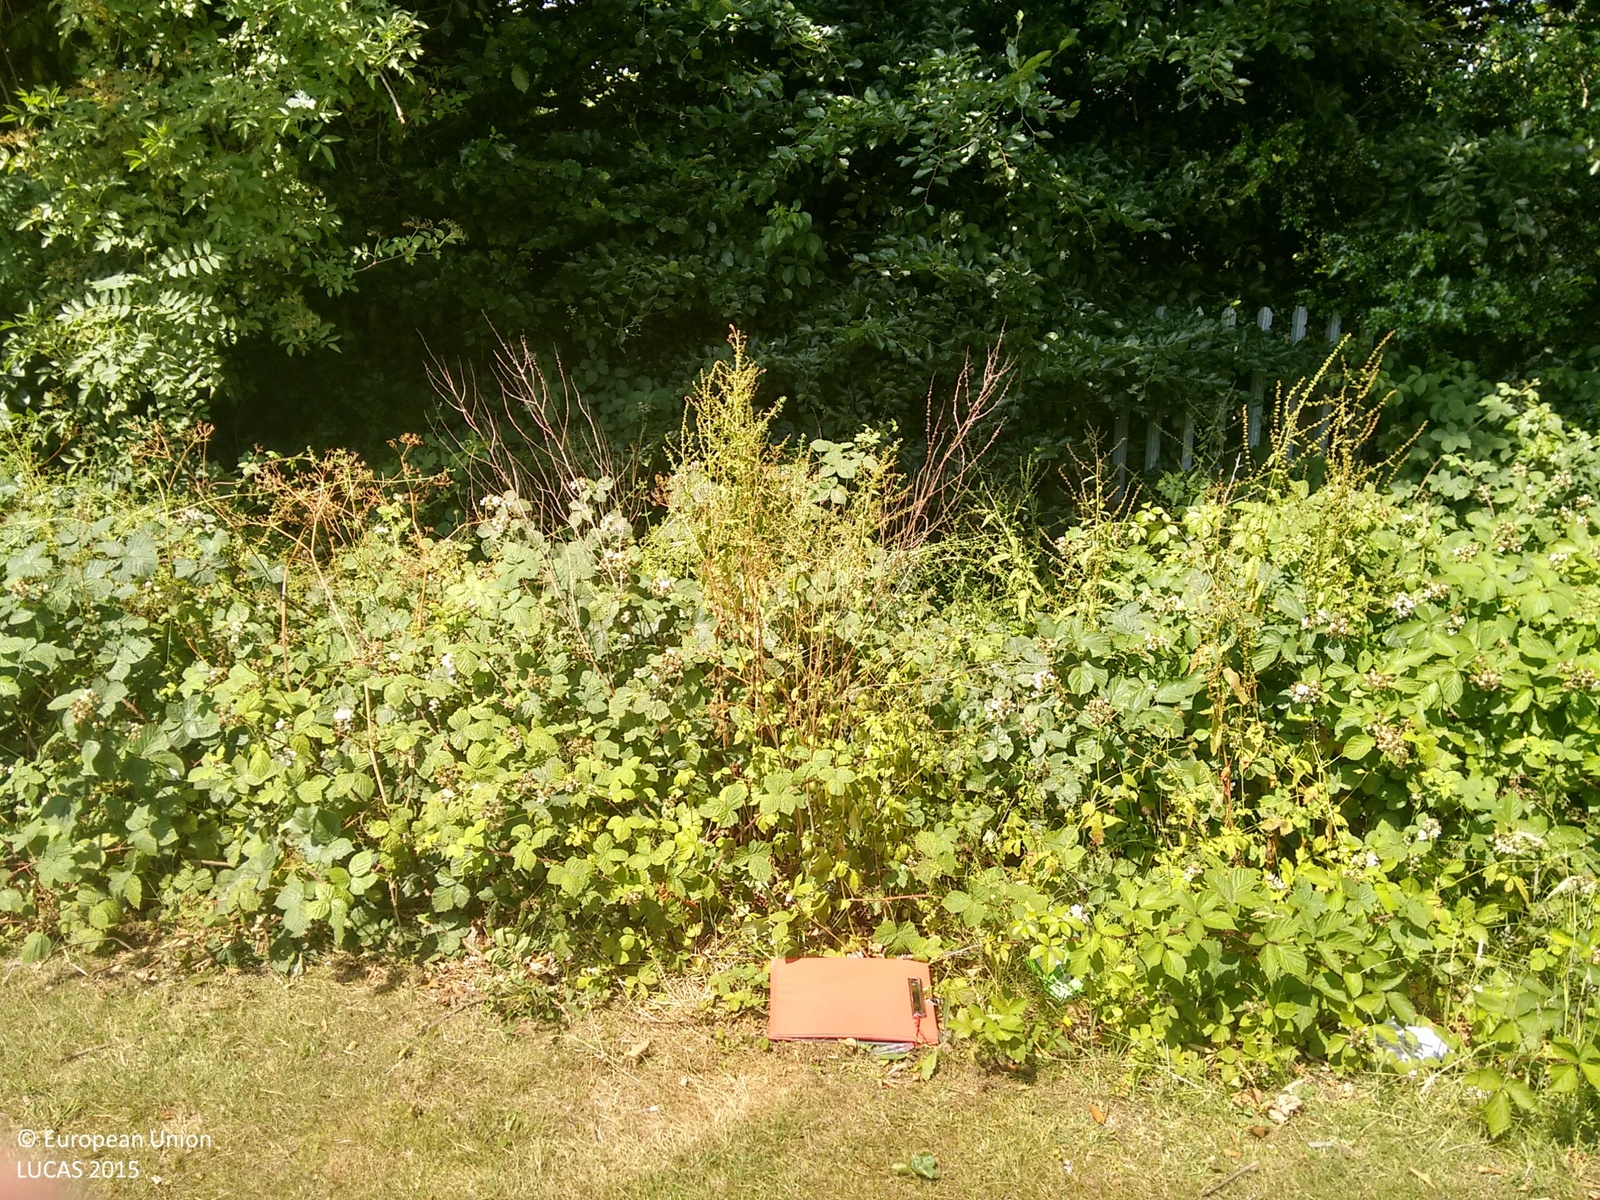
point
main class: Woodland
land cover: Broadleaved woodland
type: mesophytic deciduous forest
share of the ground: > 75 %
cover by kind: broadleaved forest trees 95 %, shrubs 5 %
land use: Semi-natural and natural areas not in use
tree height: > 5 m
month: July
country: GB
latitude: 52.4253
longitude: -1.9546
